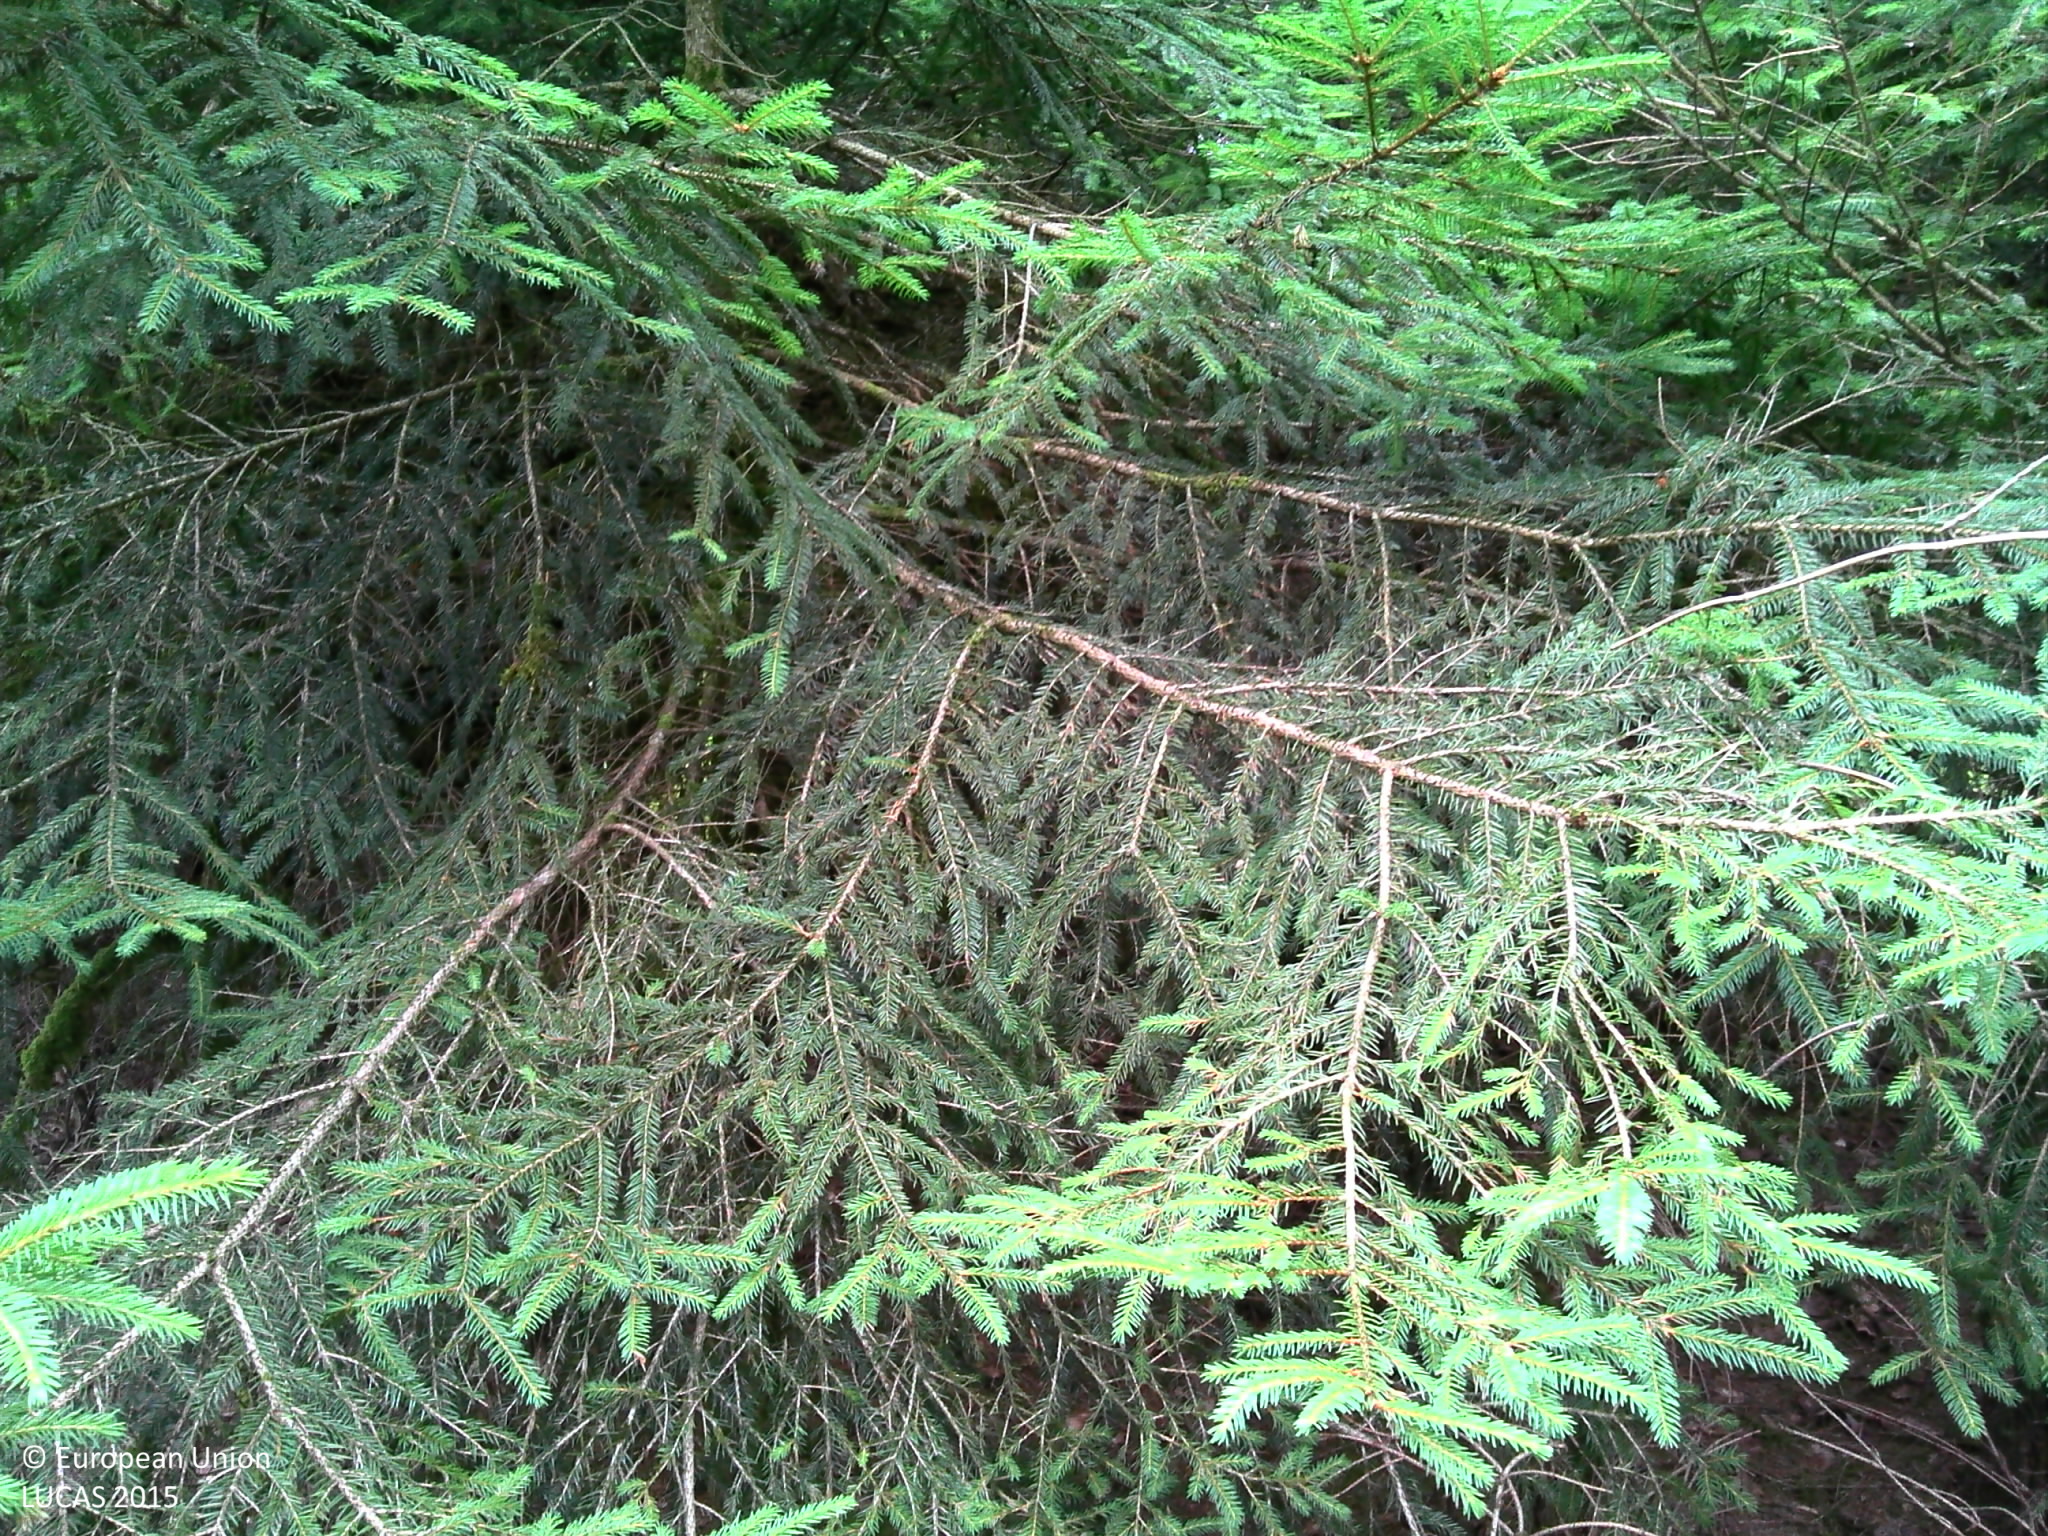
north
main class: Woodland
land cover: Spruce dominated coniferous woodland
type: hemiboreal forest and nemoral coniferous forest and mixed broadleaved-coniferous forest
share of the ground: 50 - 75 %
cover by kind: coniferous forest trees 60 %, herbaceous plants 20 %, shrubs 10 %, unconsolidated bare surface 10 %
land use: Forestry
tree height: > 5 m
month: July
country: BE
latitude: 49.7571
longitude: 5.5983
